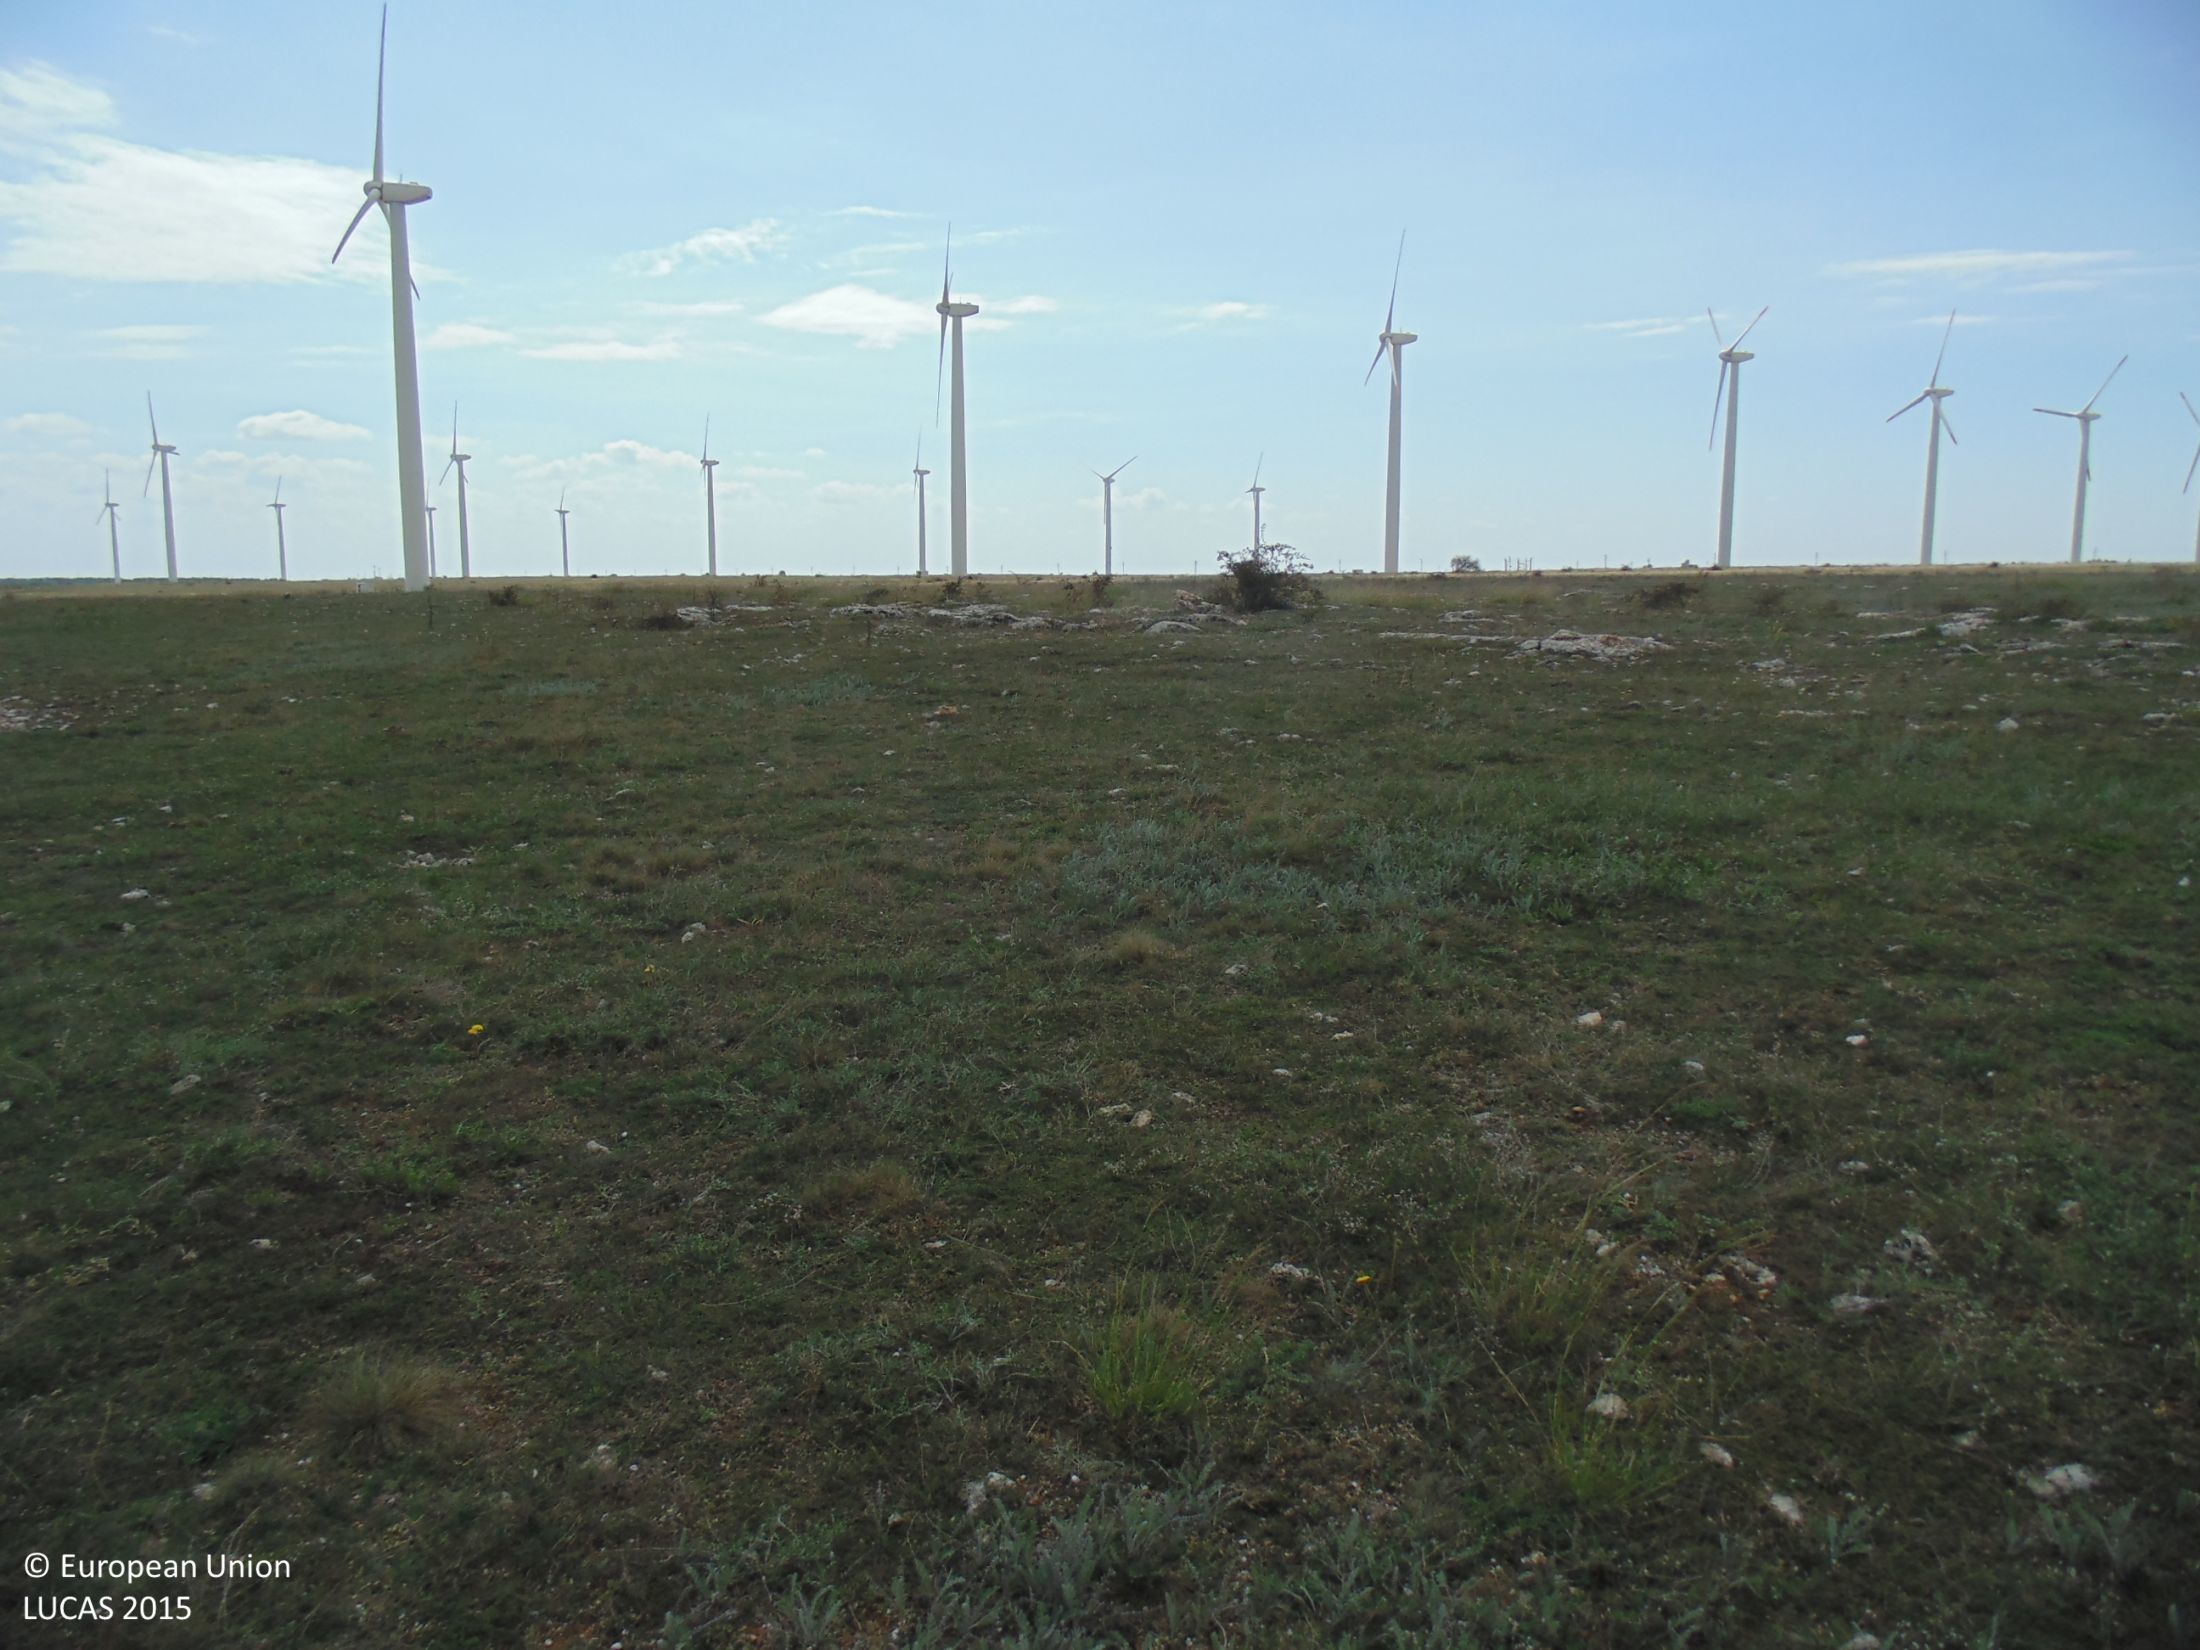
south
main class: Grassland
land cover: Grassland without tree/shrub cover
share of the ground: > 75 %
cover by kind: herbaceous plants 95 %, unconsolidated bare surface 5 %
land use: Semi-natural and natural areas not in use
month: September
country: BG
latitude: 43.3997
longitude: 28.4439
